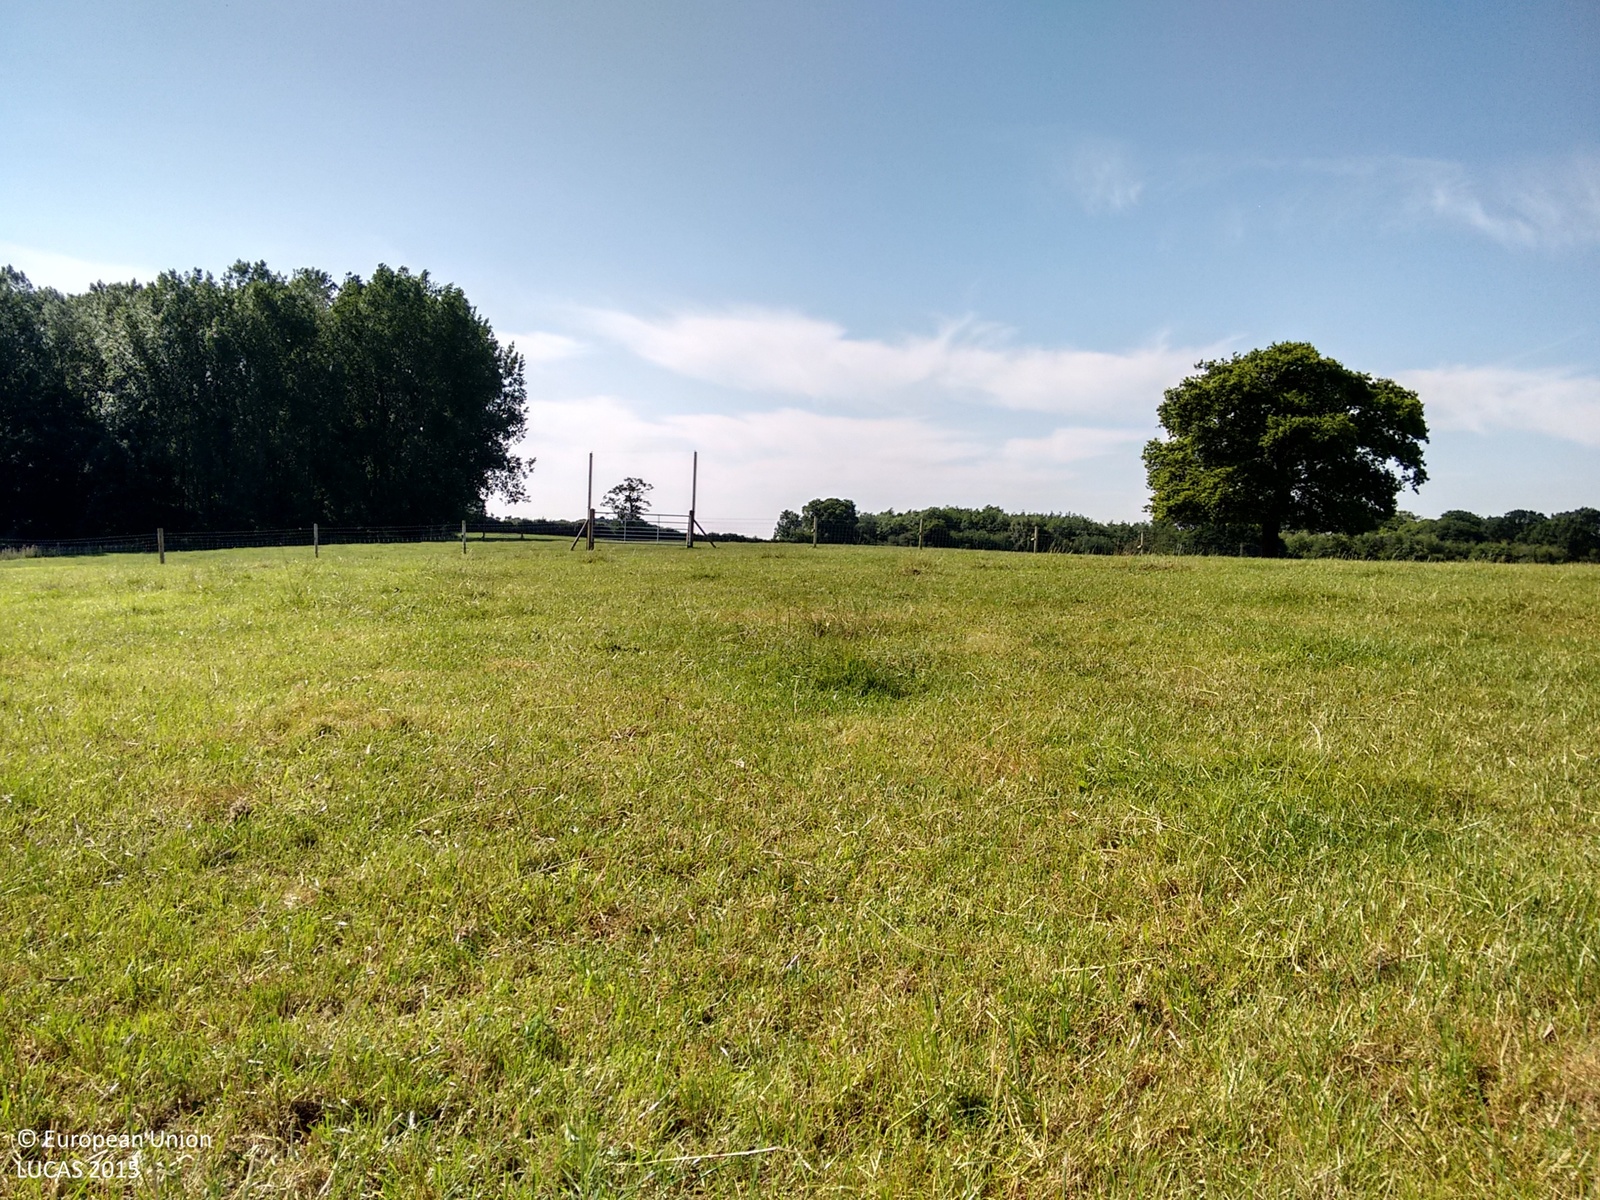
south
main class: Grassland
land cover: Grassland without tree/shrub cover
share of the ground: > 75 %
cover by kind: herbaceous plants 100 %
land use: Agriculture (excluding fallow land and kitchen gardens)
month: July
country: GB
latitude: 53.0287
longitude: -2.4558
